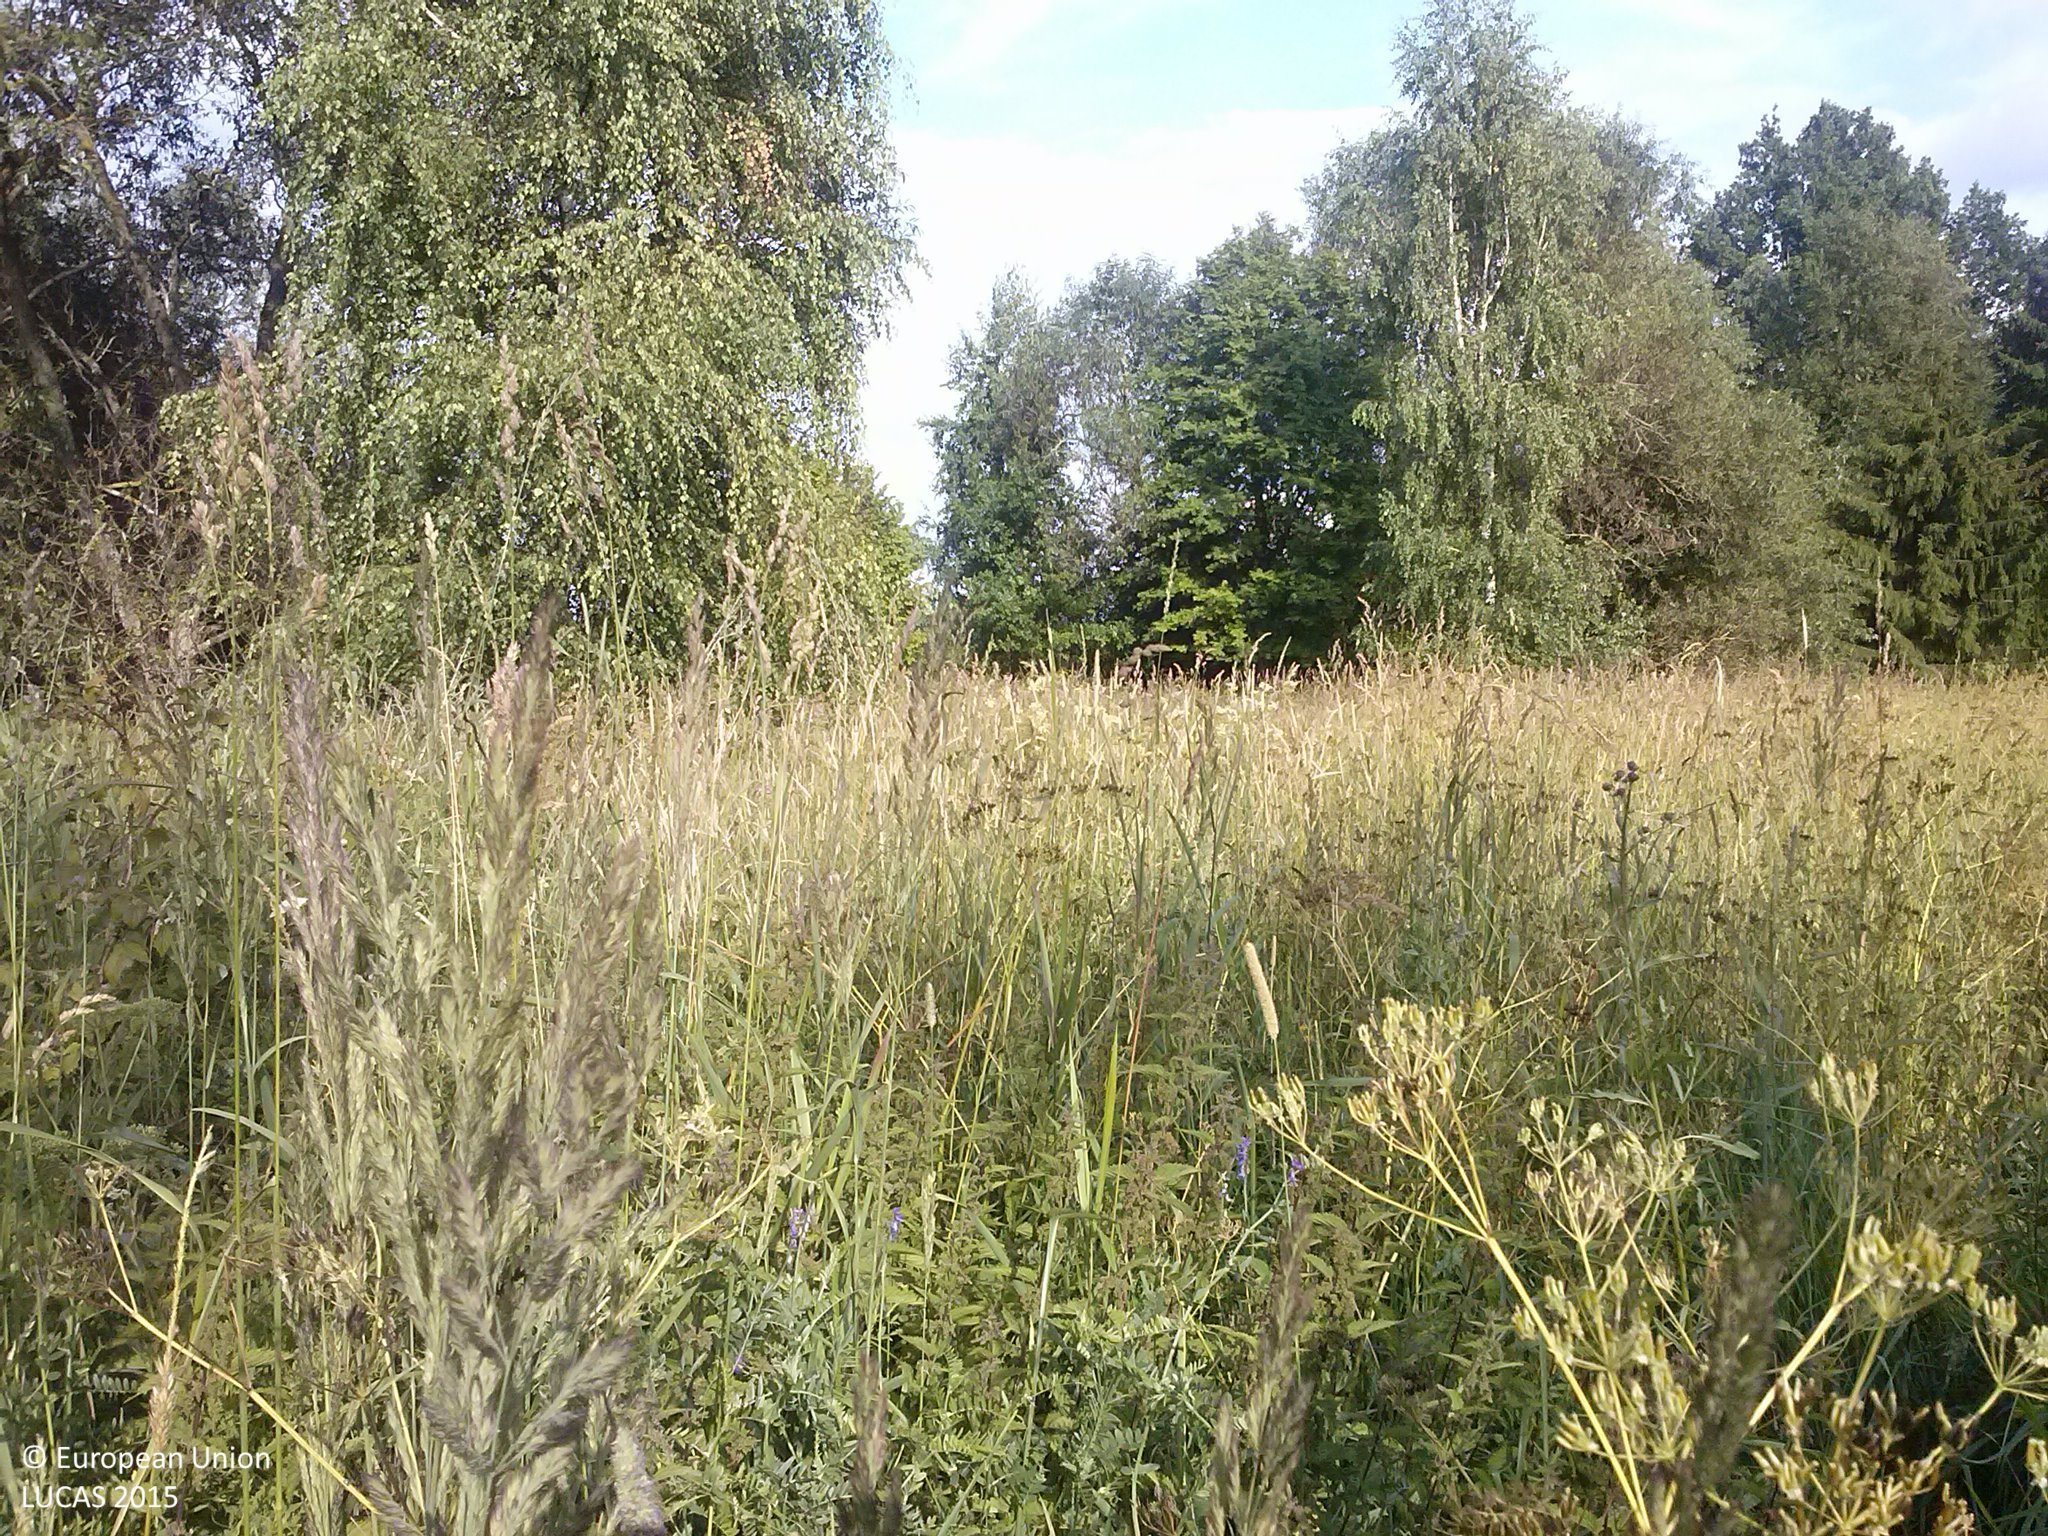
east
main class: Grassland
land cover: Spontaneously vegetated surfaces
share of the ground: > 75 %
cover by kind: herbaceous plants 100 %
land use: Semi-natural and natural areas not in use
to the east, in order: Spontaneously vegetated surfaces; Broadleaved woodland; Spontaneously vegetated surfaces; Artificial constructions in urban areas; Spontaneously vegetated surfaces; Broadleaved woodland; Grassland without tree/shrub cover; Grassland with sparse tree/shrub cover
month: July
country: LV
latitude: 56.6655
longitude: 27.3887
